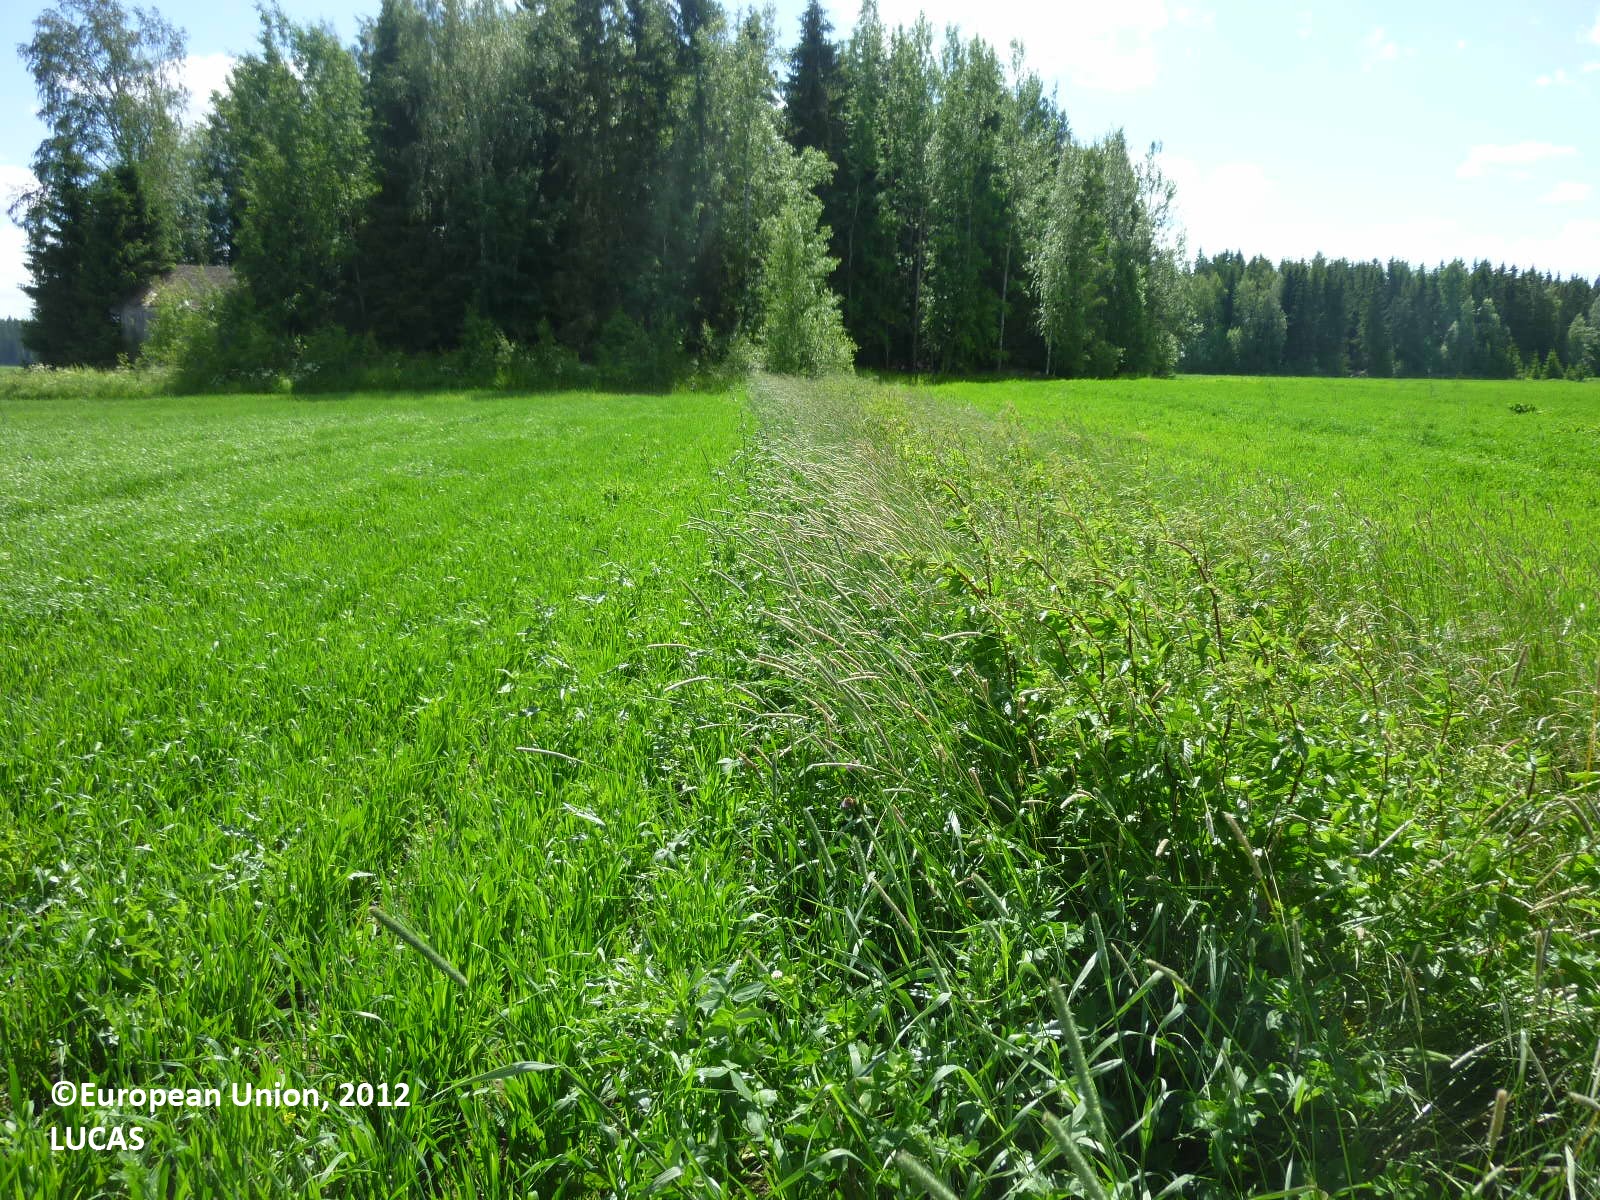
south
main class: Cropland
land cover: Barley
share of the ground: > 75 %
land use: Agriculture (excluding fallow land and kitchen gardens)
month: July
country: FI
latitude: 61.1840
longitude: 22.8103
